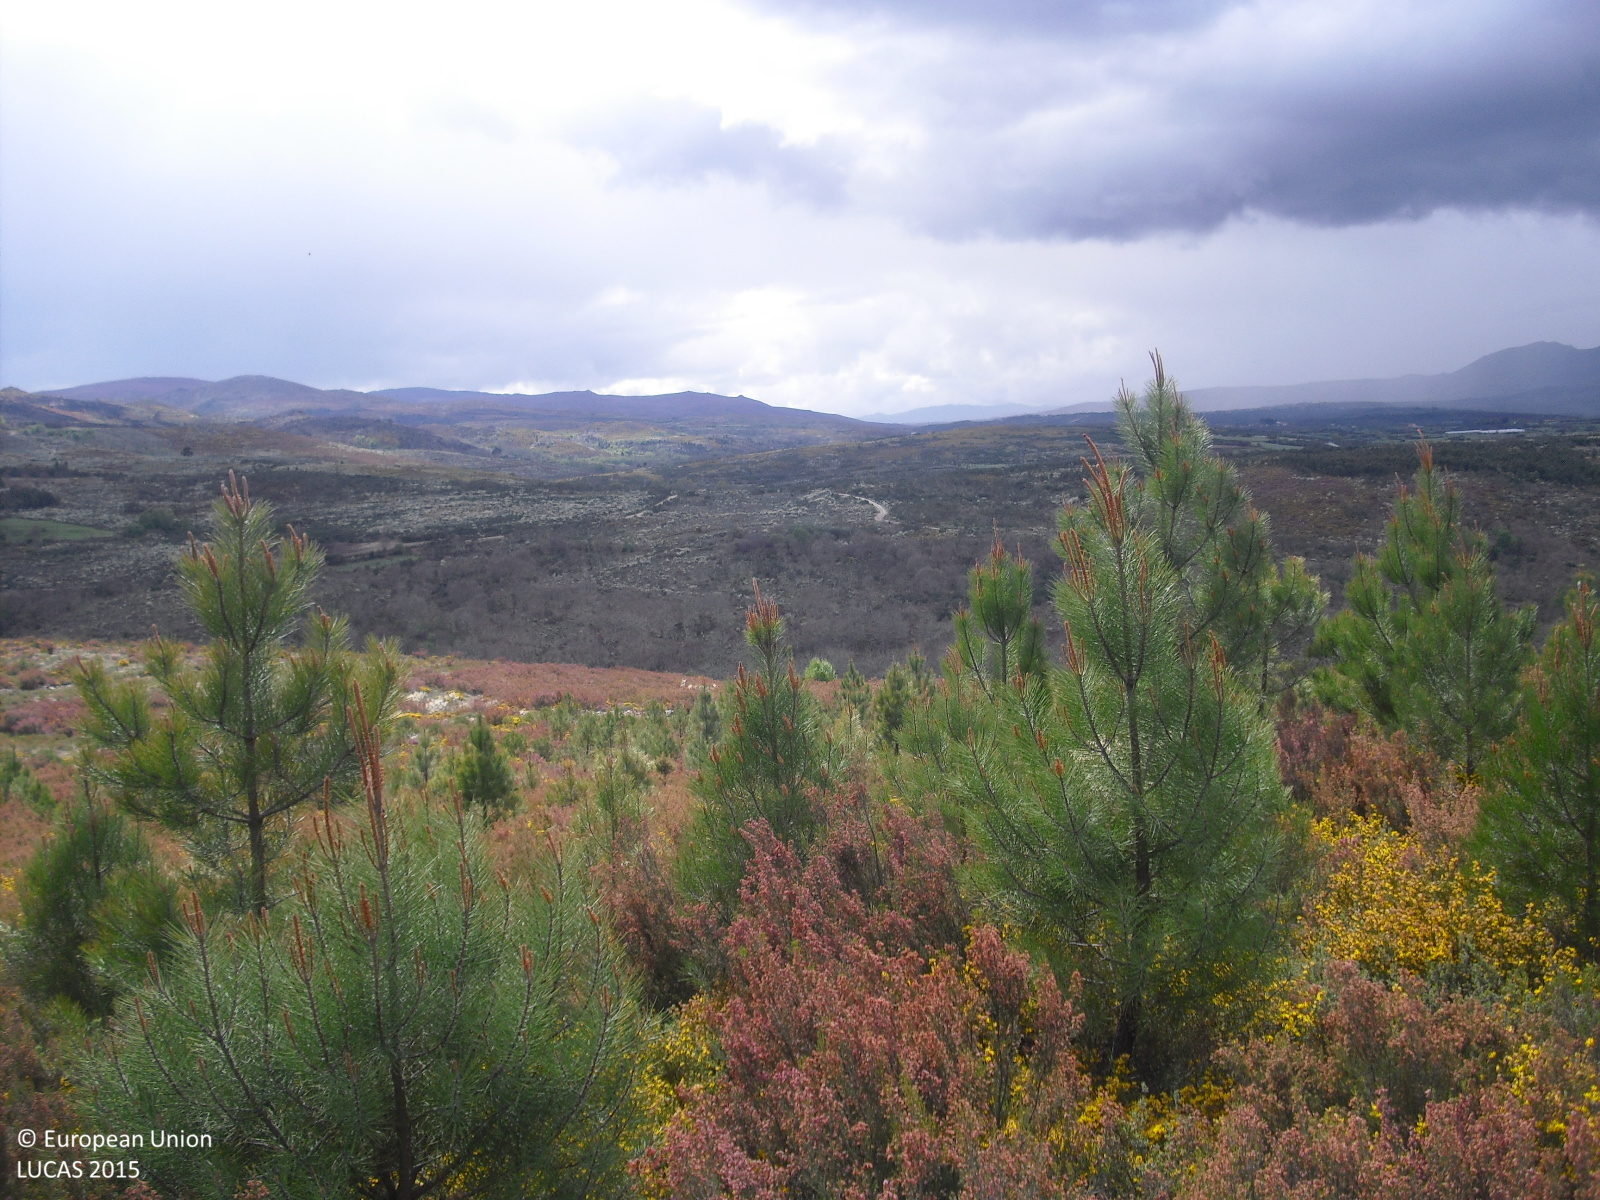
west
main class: Woodland
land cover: Pine dominated coniferous woodland
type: exotic forest
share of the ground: 10 - 25 %
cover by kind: shrubs 50 %, coniferous forest trees 30 %, herbaceous plants 15 %, consolidated bare surface 5 %
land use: Forestry
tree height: < 5 m
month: April
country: ES
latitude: 41.8348
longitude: -7.6078
